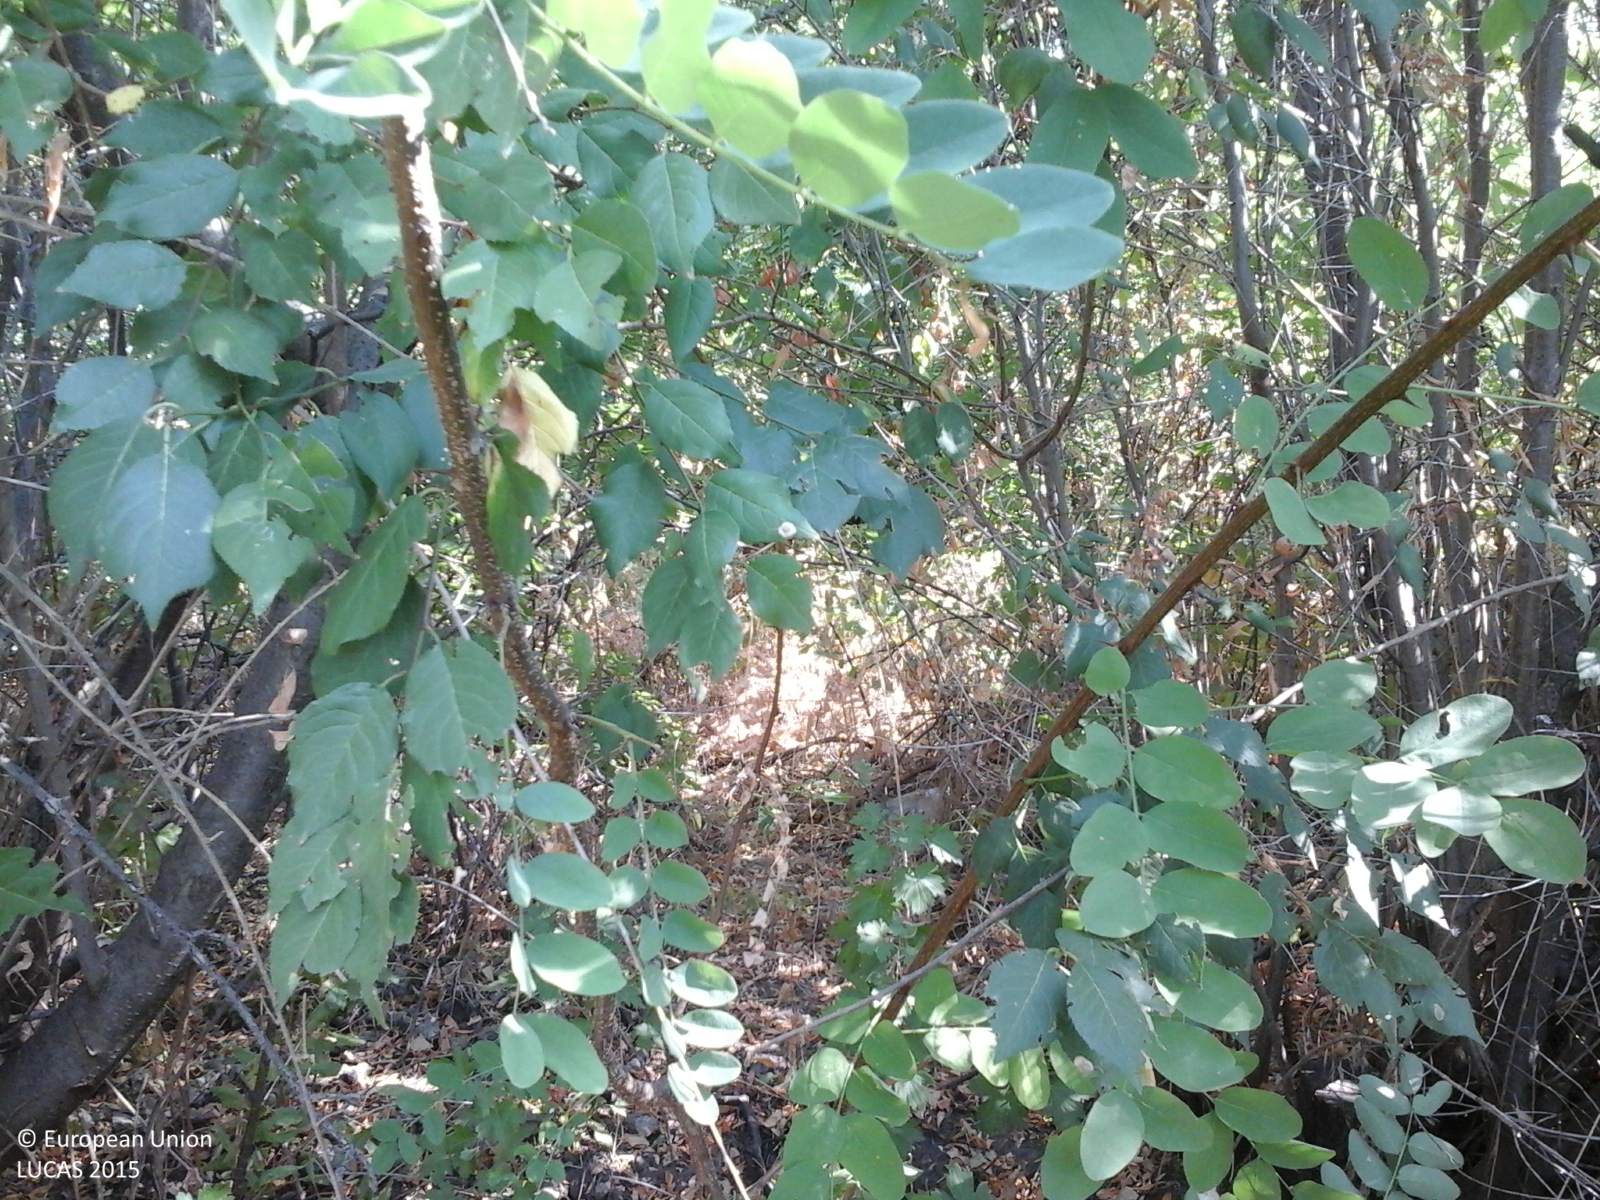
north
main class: Shrubland
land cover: Shrubland with sparse tree cover
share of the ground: > 75 %
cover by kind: shrubs 95 %, broadleaved forest trees 5 %
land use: Semi-natural and natural areas not in use
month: August
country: RO
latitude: 44.0650
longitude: 23.0896
